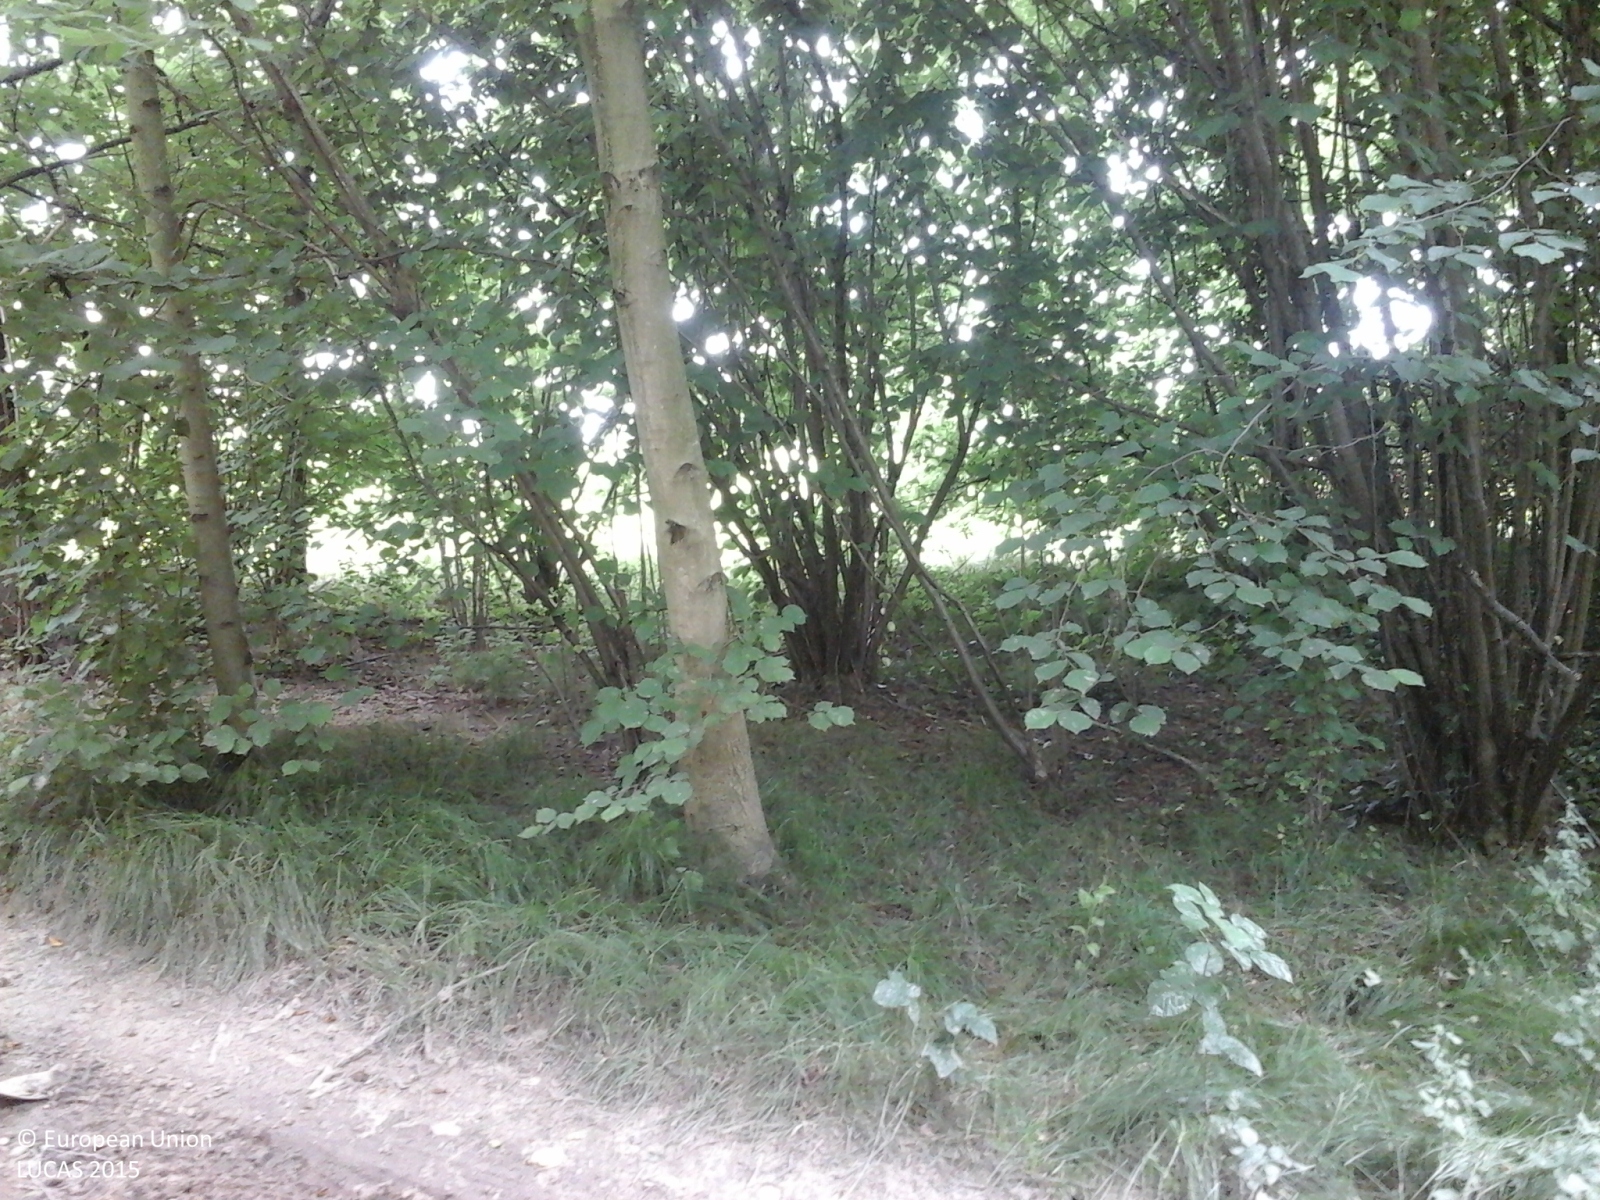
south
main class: Woodland
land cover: Broadleaved woodland
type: thermophilous deciduous forest
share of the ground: > 75 %
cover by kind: broadleaved forest trees 100 %
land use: Semi-natural and natural areas not in use
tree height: > 5 m
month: June
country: IT
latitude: 45.3339
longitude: 7.6432
